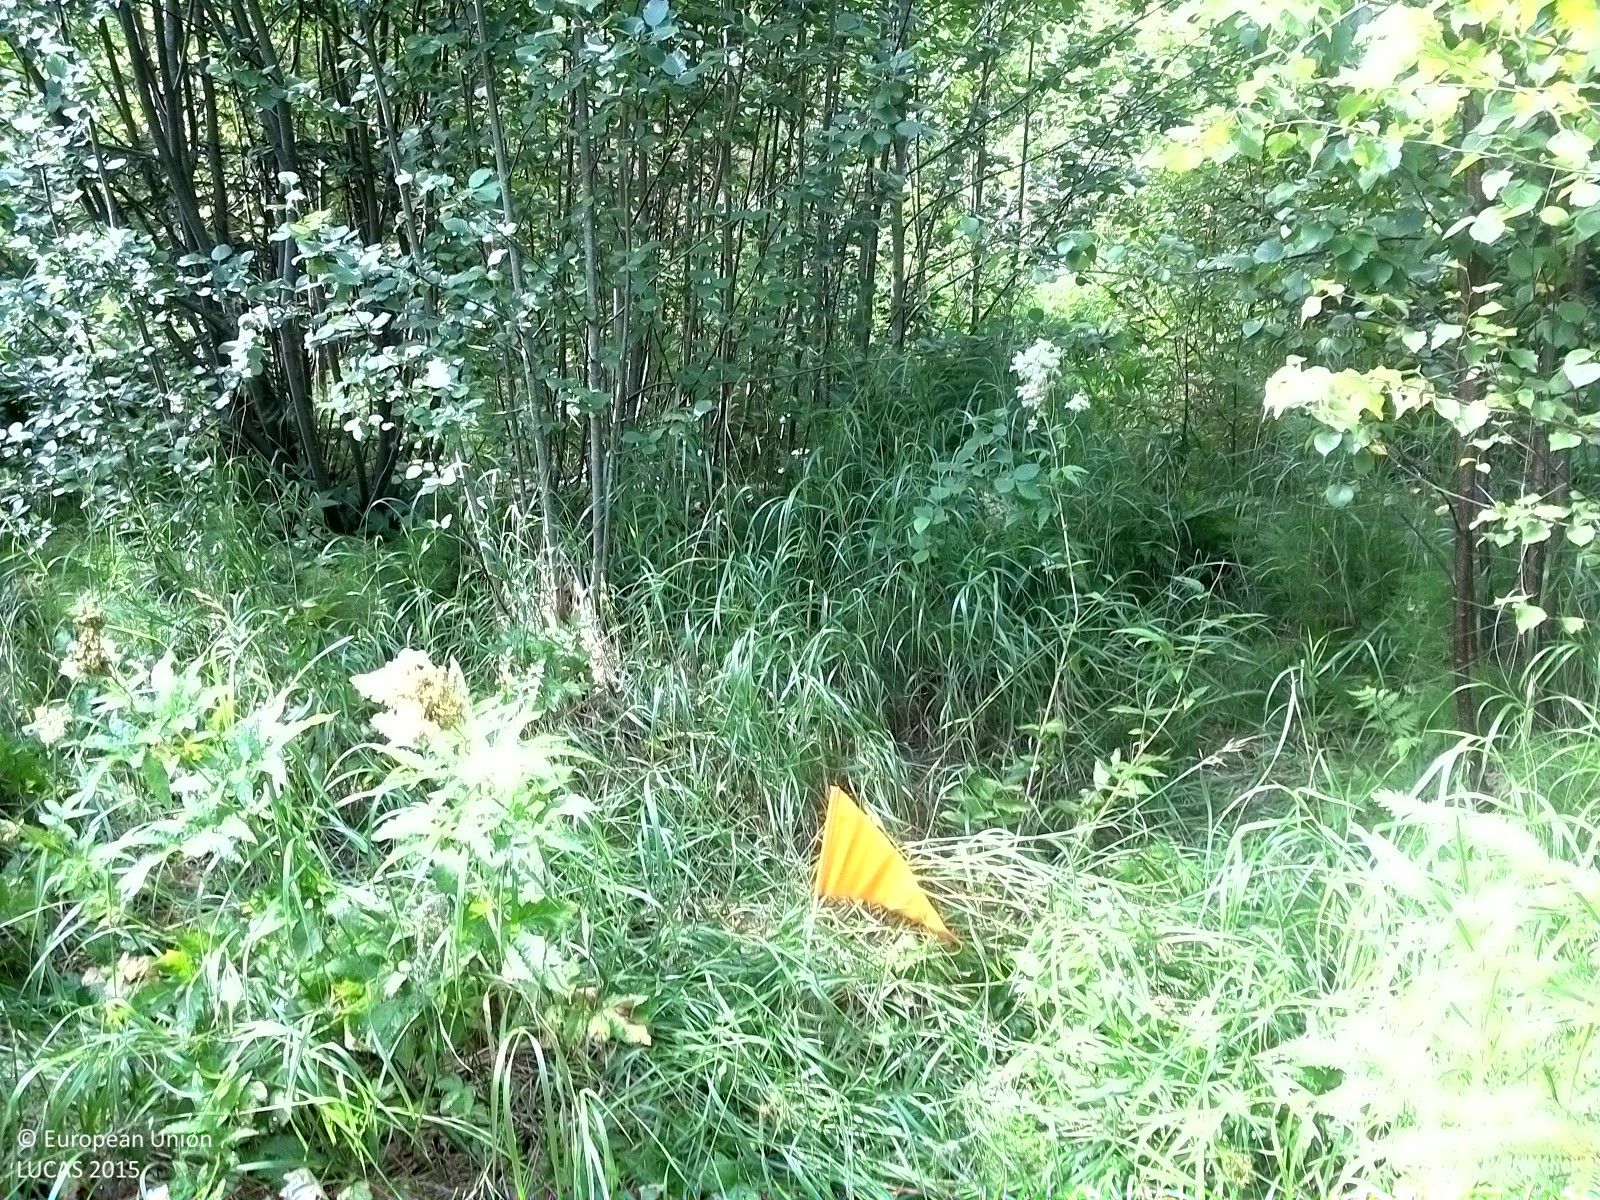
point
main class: Woodland
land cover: Other mixed woodland
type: boreal forest
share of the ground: 50 - 75 %
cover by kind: herbaceous plants 45 %, broadleaved forest trees 40 %, coniferous forest trees 15 %
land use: Semi-natural and natural areas not in use
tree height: < 5 m
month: August
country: SE
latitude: 62.5114
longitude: 17.2233
